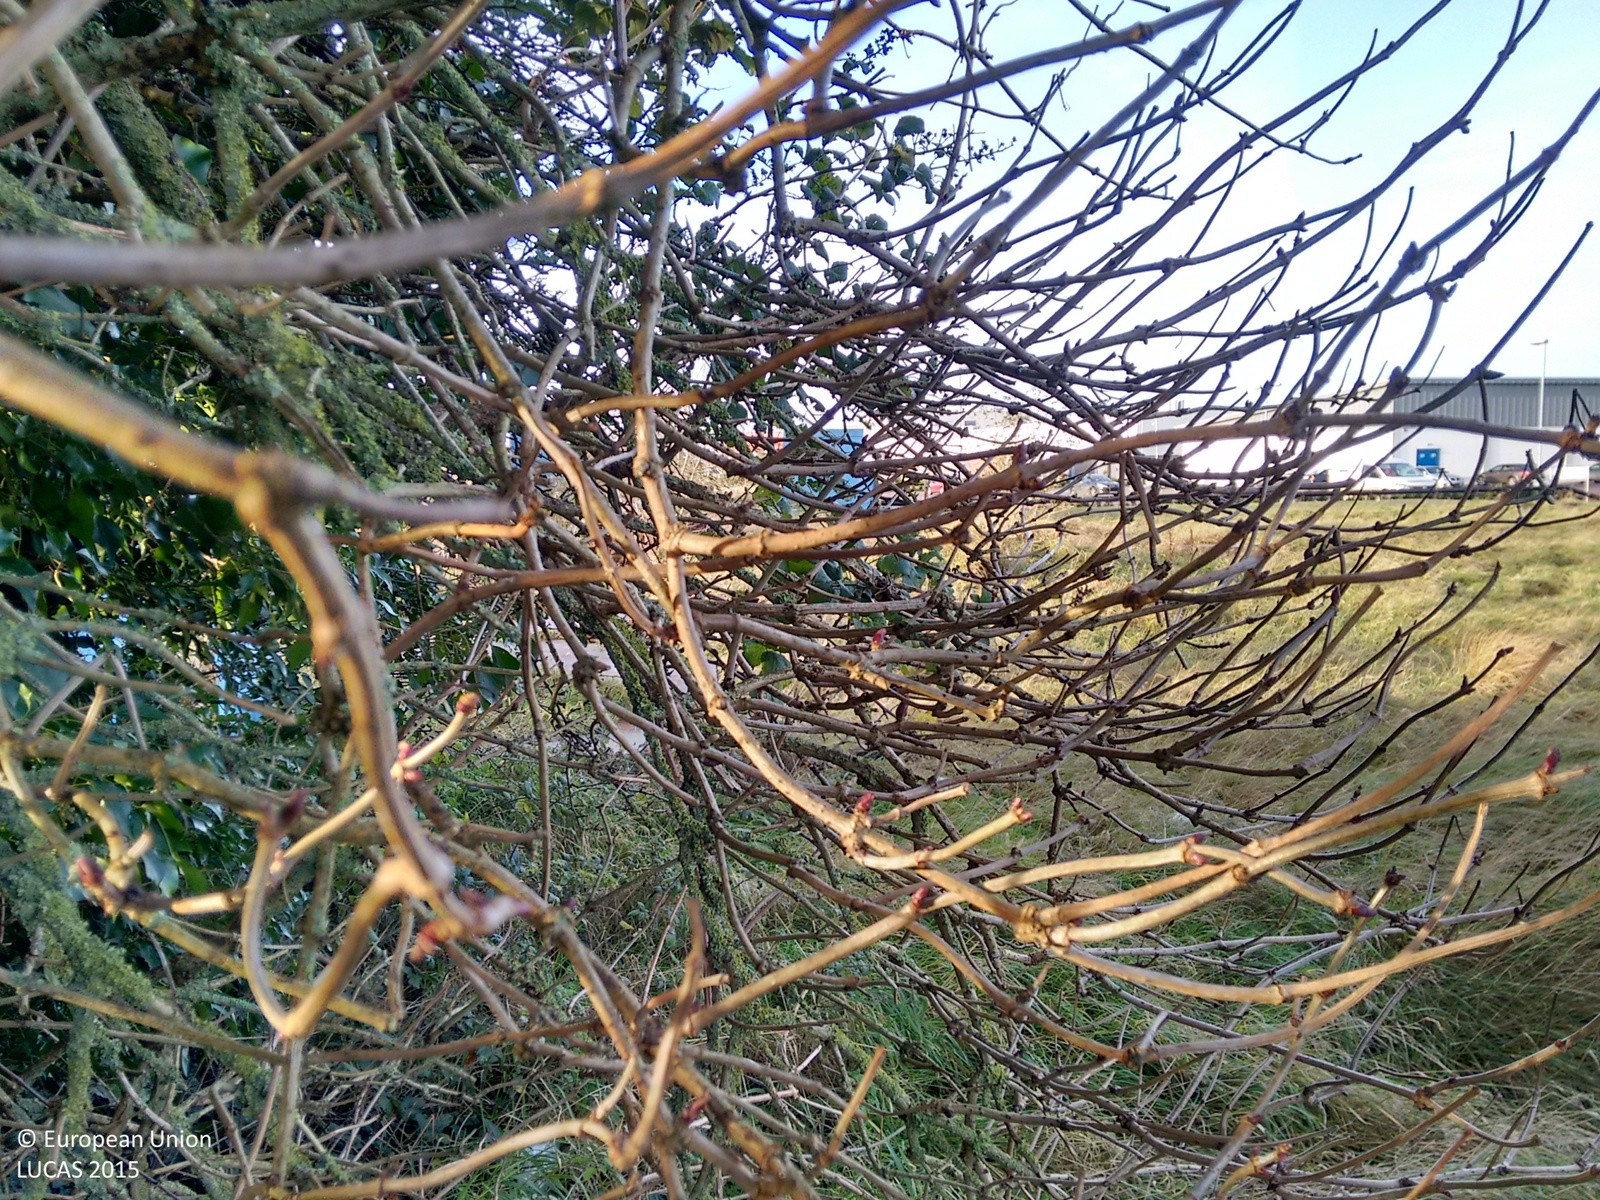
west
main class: Grassland
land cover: Spontaneously vegetated surfaces
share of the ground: > 75 %
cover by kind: herbaceous plants 95 %, shrubs 5 %
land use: Abandoned areas
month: December
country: IE
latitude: 53.7262
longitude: -6.3855
